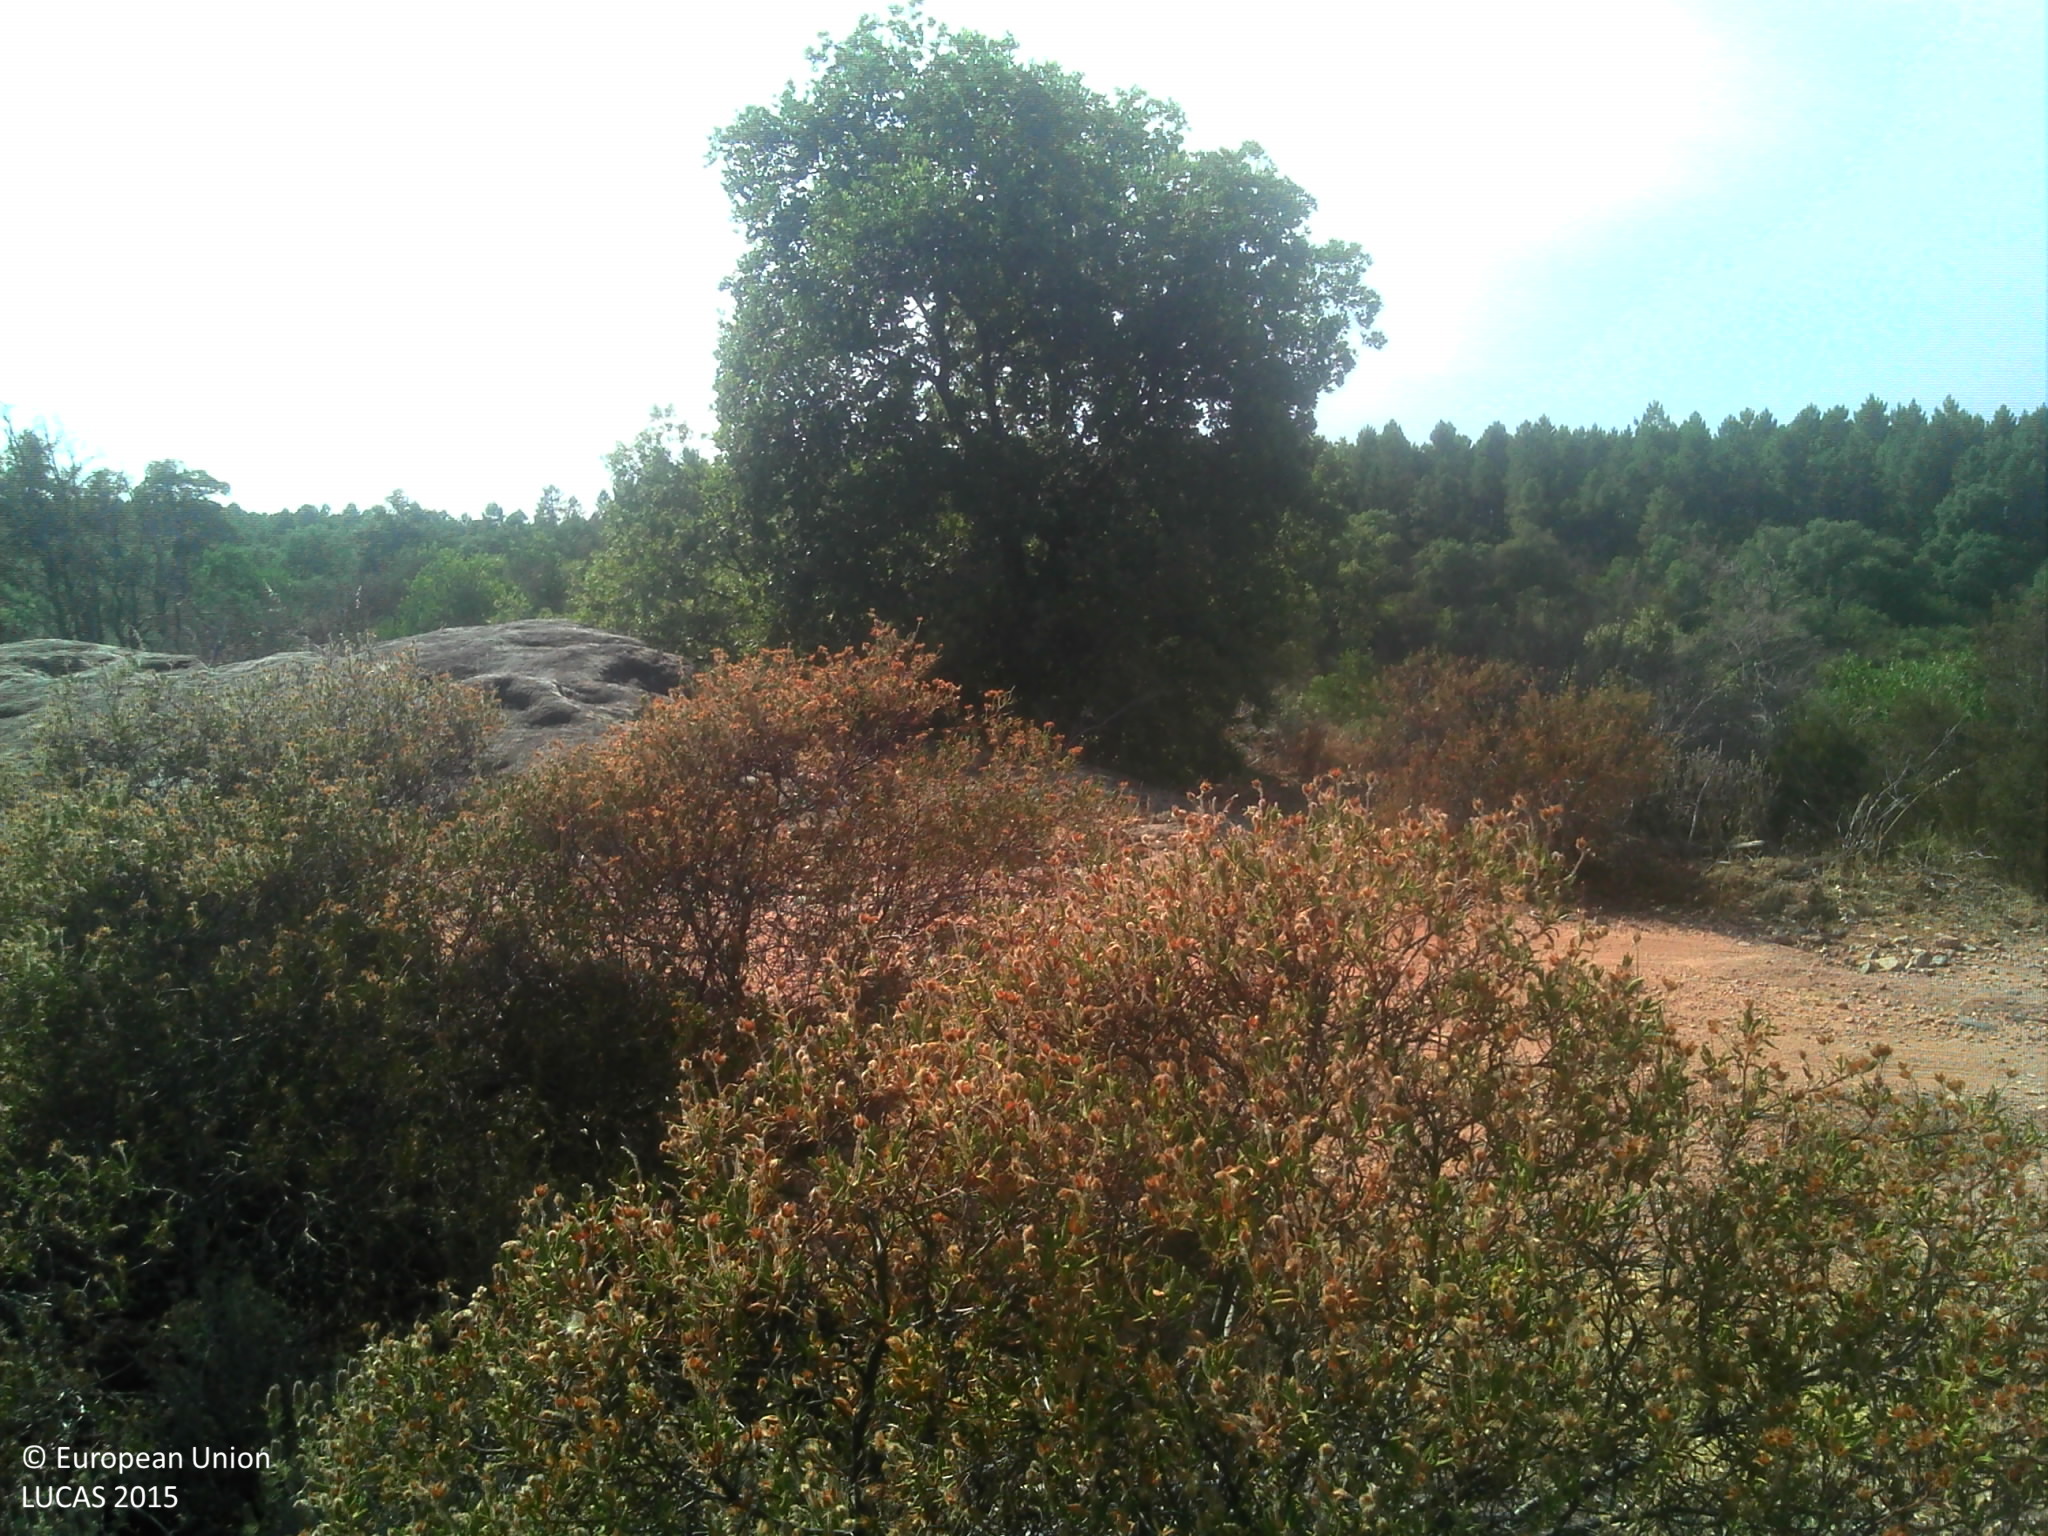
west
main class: Shrubland
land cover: Shrubland without tree cover
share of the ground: > 75 %
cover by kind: shrubs 100 %
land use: Semi-natural and natural areas not in use
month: July
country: FR
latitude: 43.3300
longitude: 6.3709
